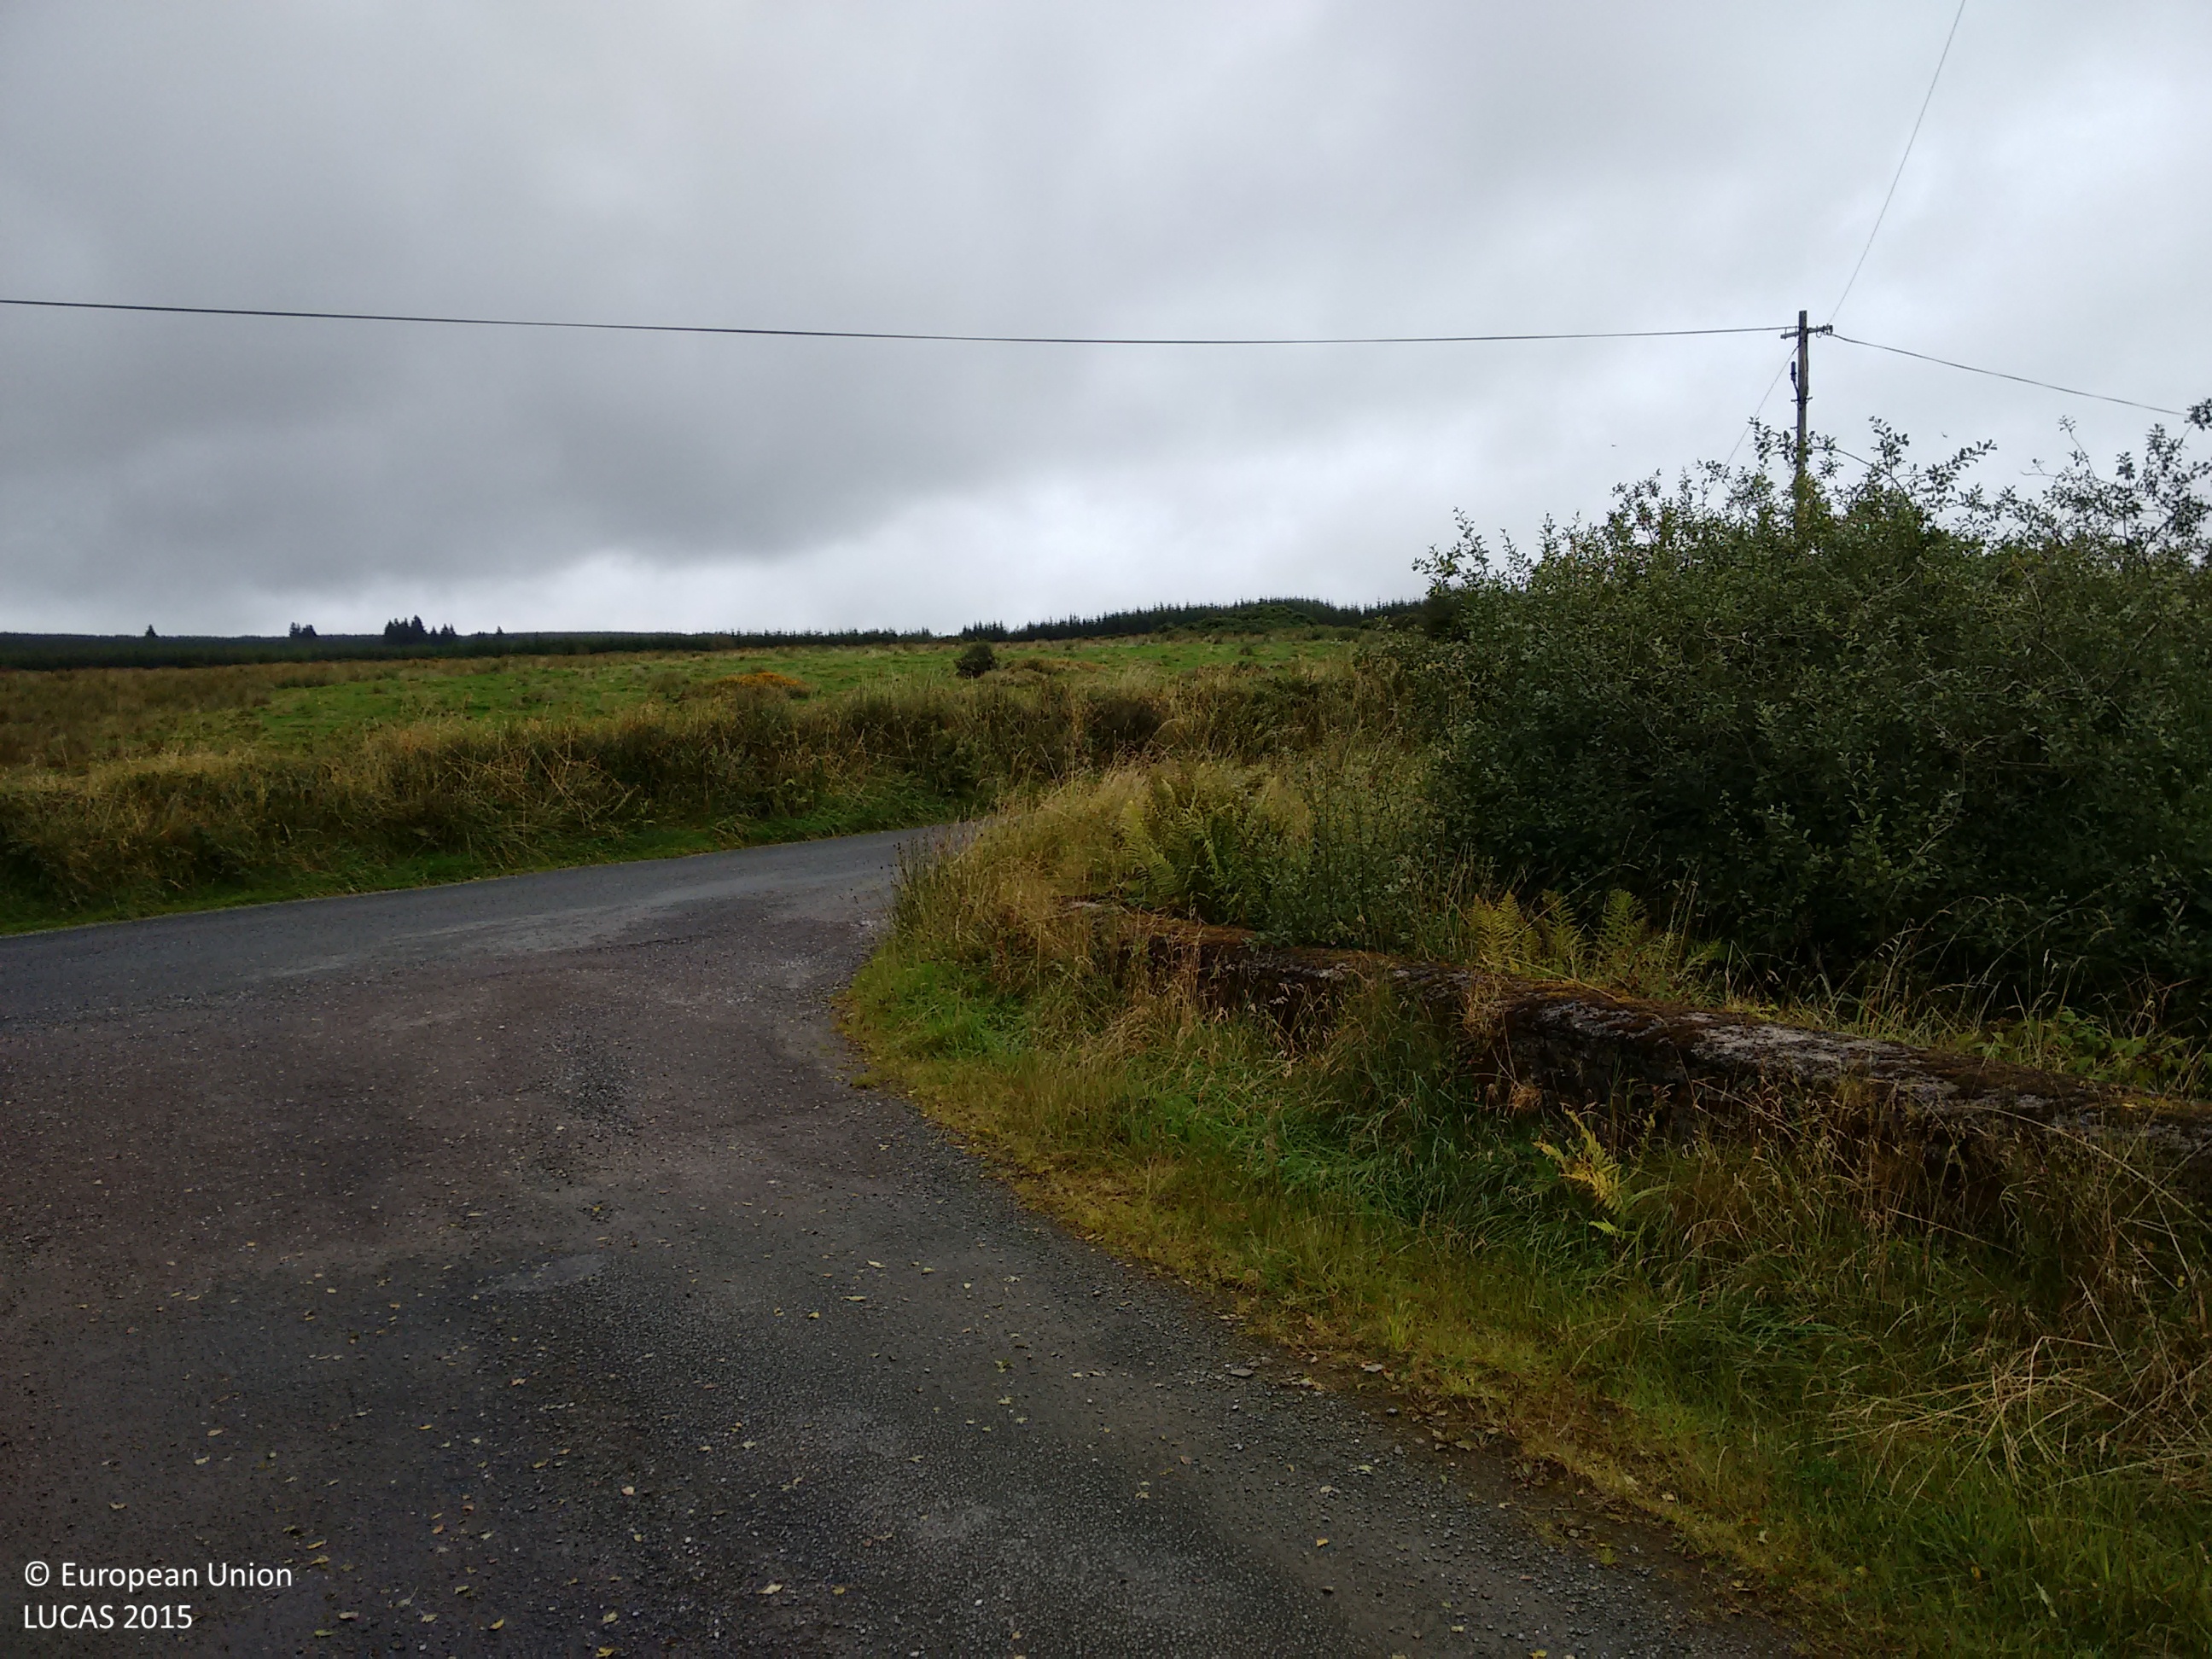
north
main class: Grassland
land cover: Grassland without tree/shrub cover
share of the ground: > 75 %
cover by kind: herbaceous plants 100 %
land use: Agriculture (excluding fallow land and kitchen gardens)
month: September
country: IE
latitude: 52.2913
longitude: -9.1771
